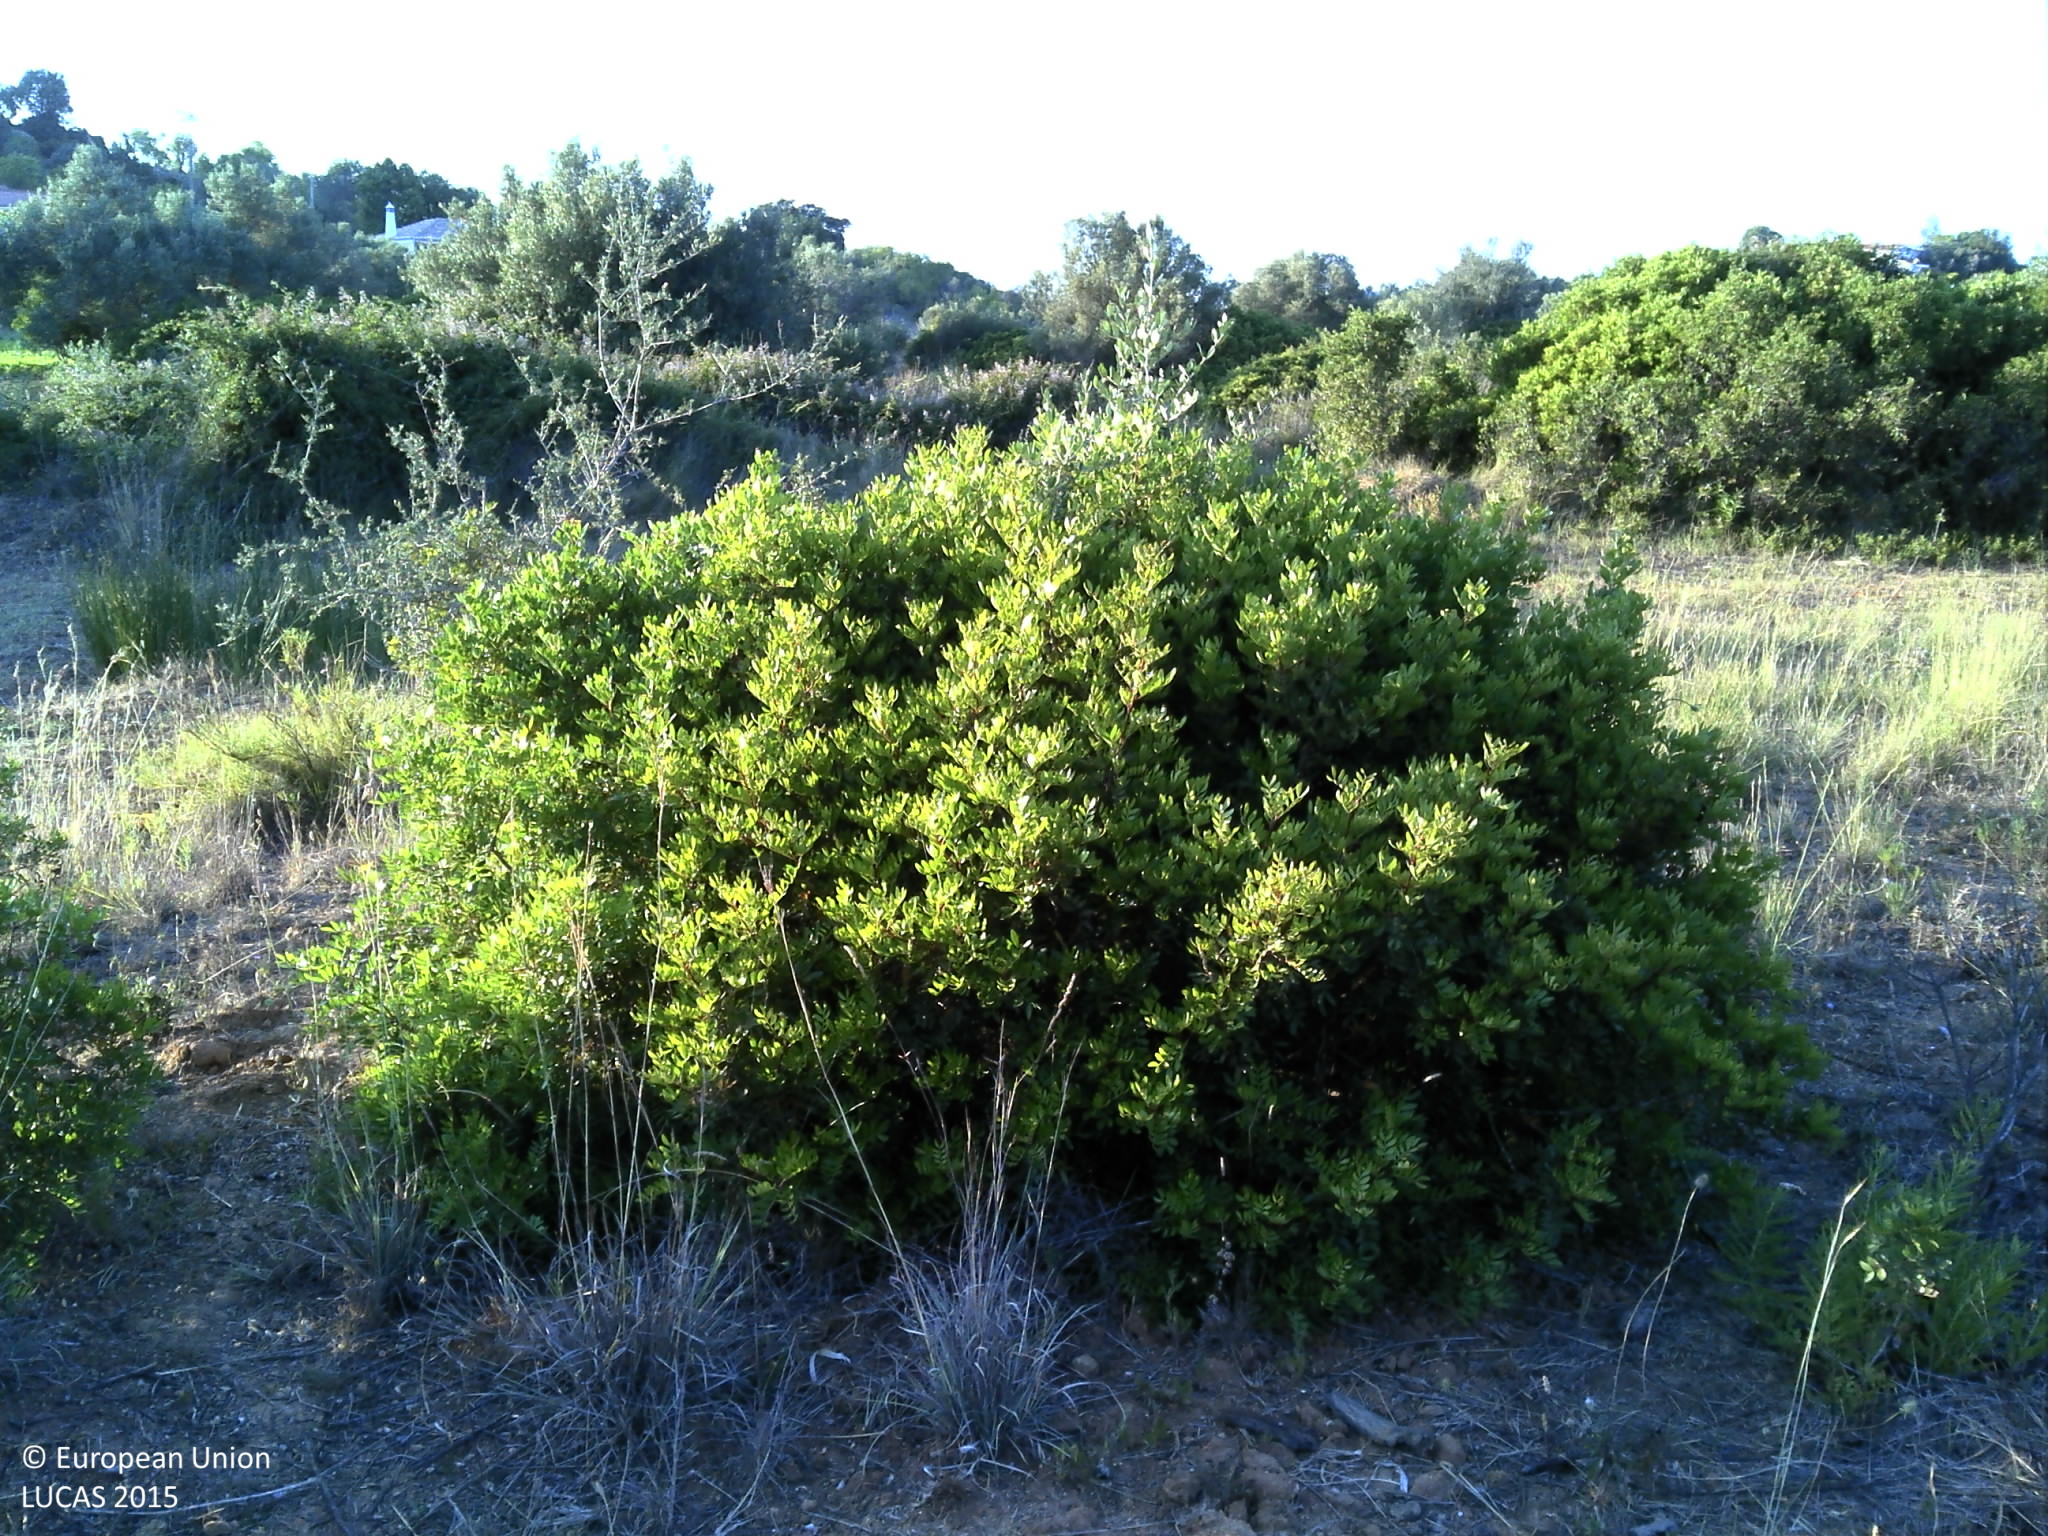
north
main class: Shrubland
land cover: Shrubland without tree cover
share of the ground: 25 - 50 %
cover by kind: shrubs 55 %, herbaceous plants 45 %
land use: Semi-natural and natural areas not in use
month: June
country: PT
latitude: 37.0518
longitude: -7.8068
